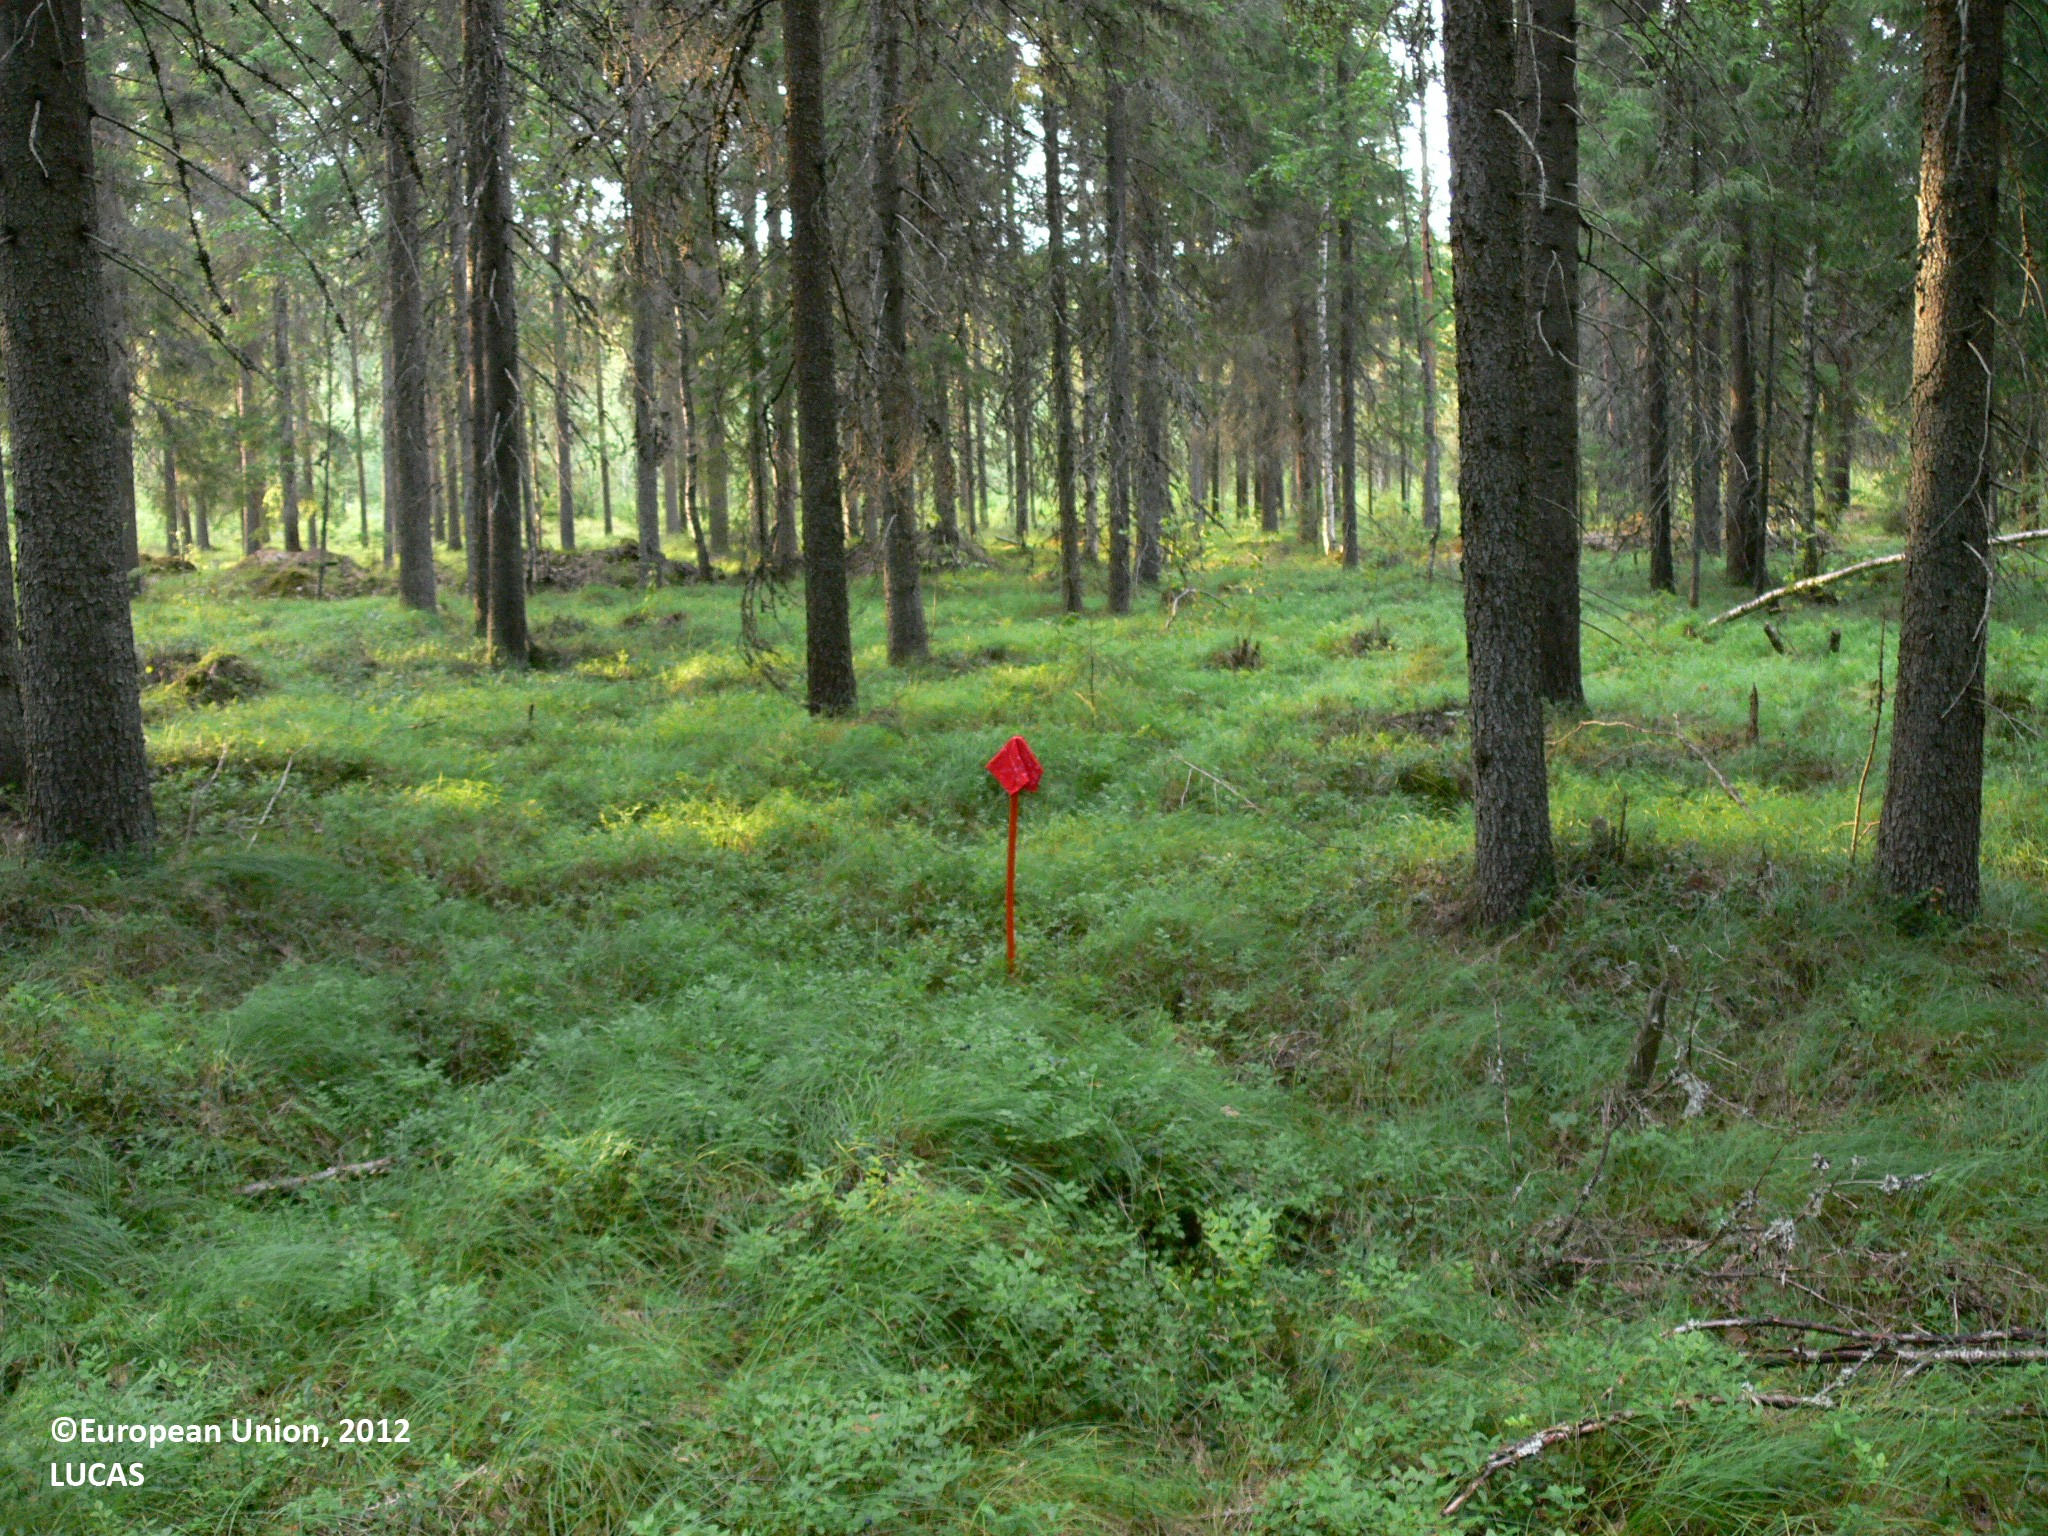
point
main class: Woodland
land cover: Spruce dominated coniferous woodland
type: boreal forest
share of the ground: > 75 %
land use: Forestry
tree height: > 5 m
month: August
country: FI
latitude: 62.1804
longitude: 30.5525
